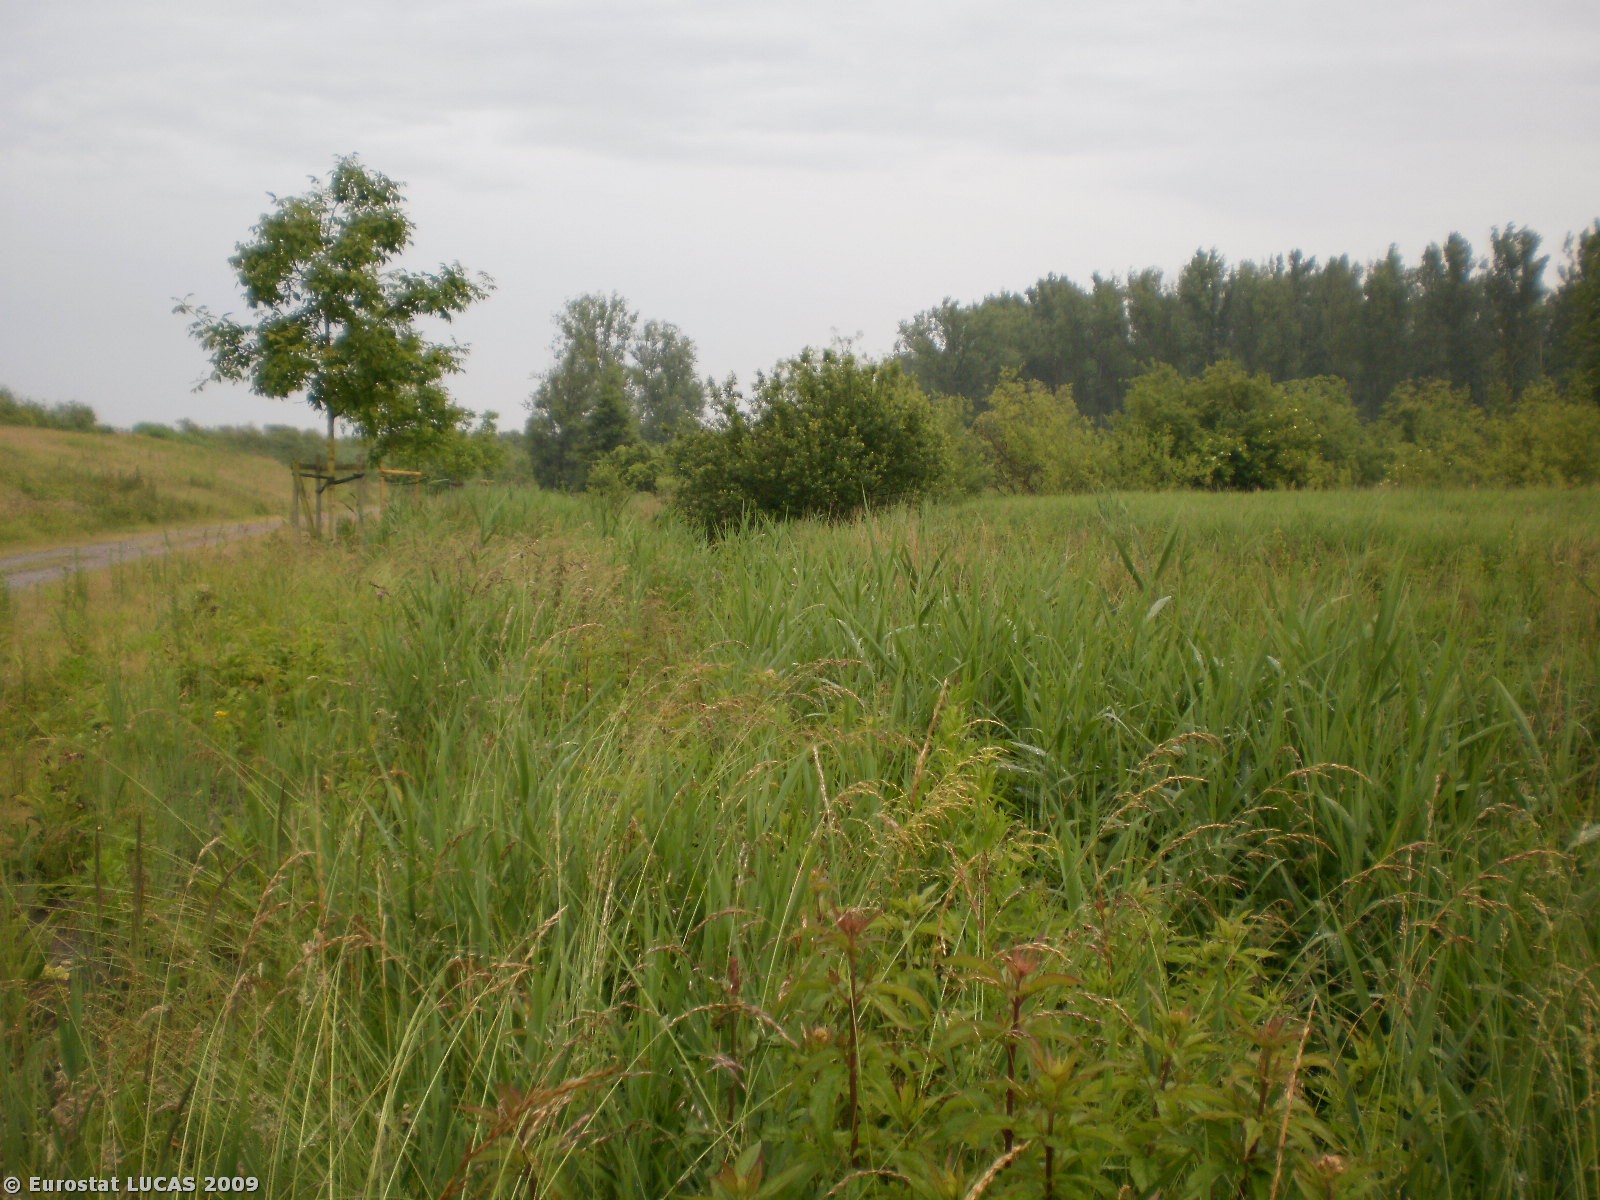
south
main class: Grassland
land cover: Grassland with sparse tree/shrub cover
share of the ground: > 75 %
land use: Nature reserves
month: June
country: BE
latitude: 51.0814
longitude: 4.1849
